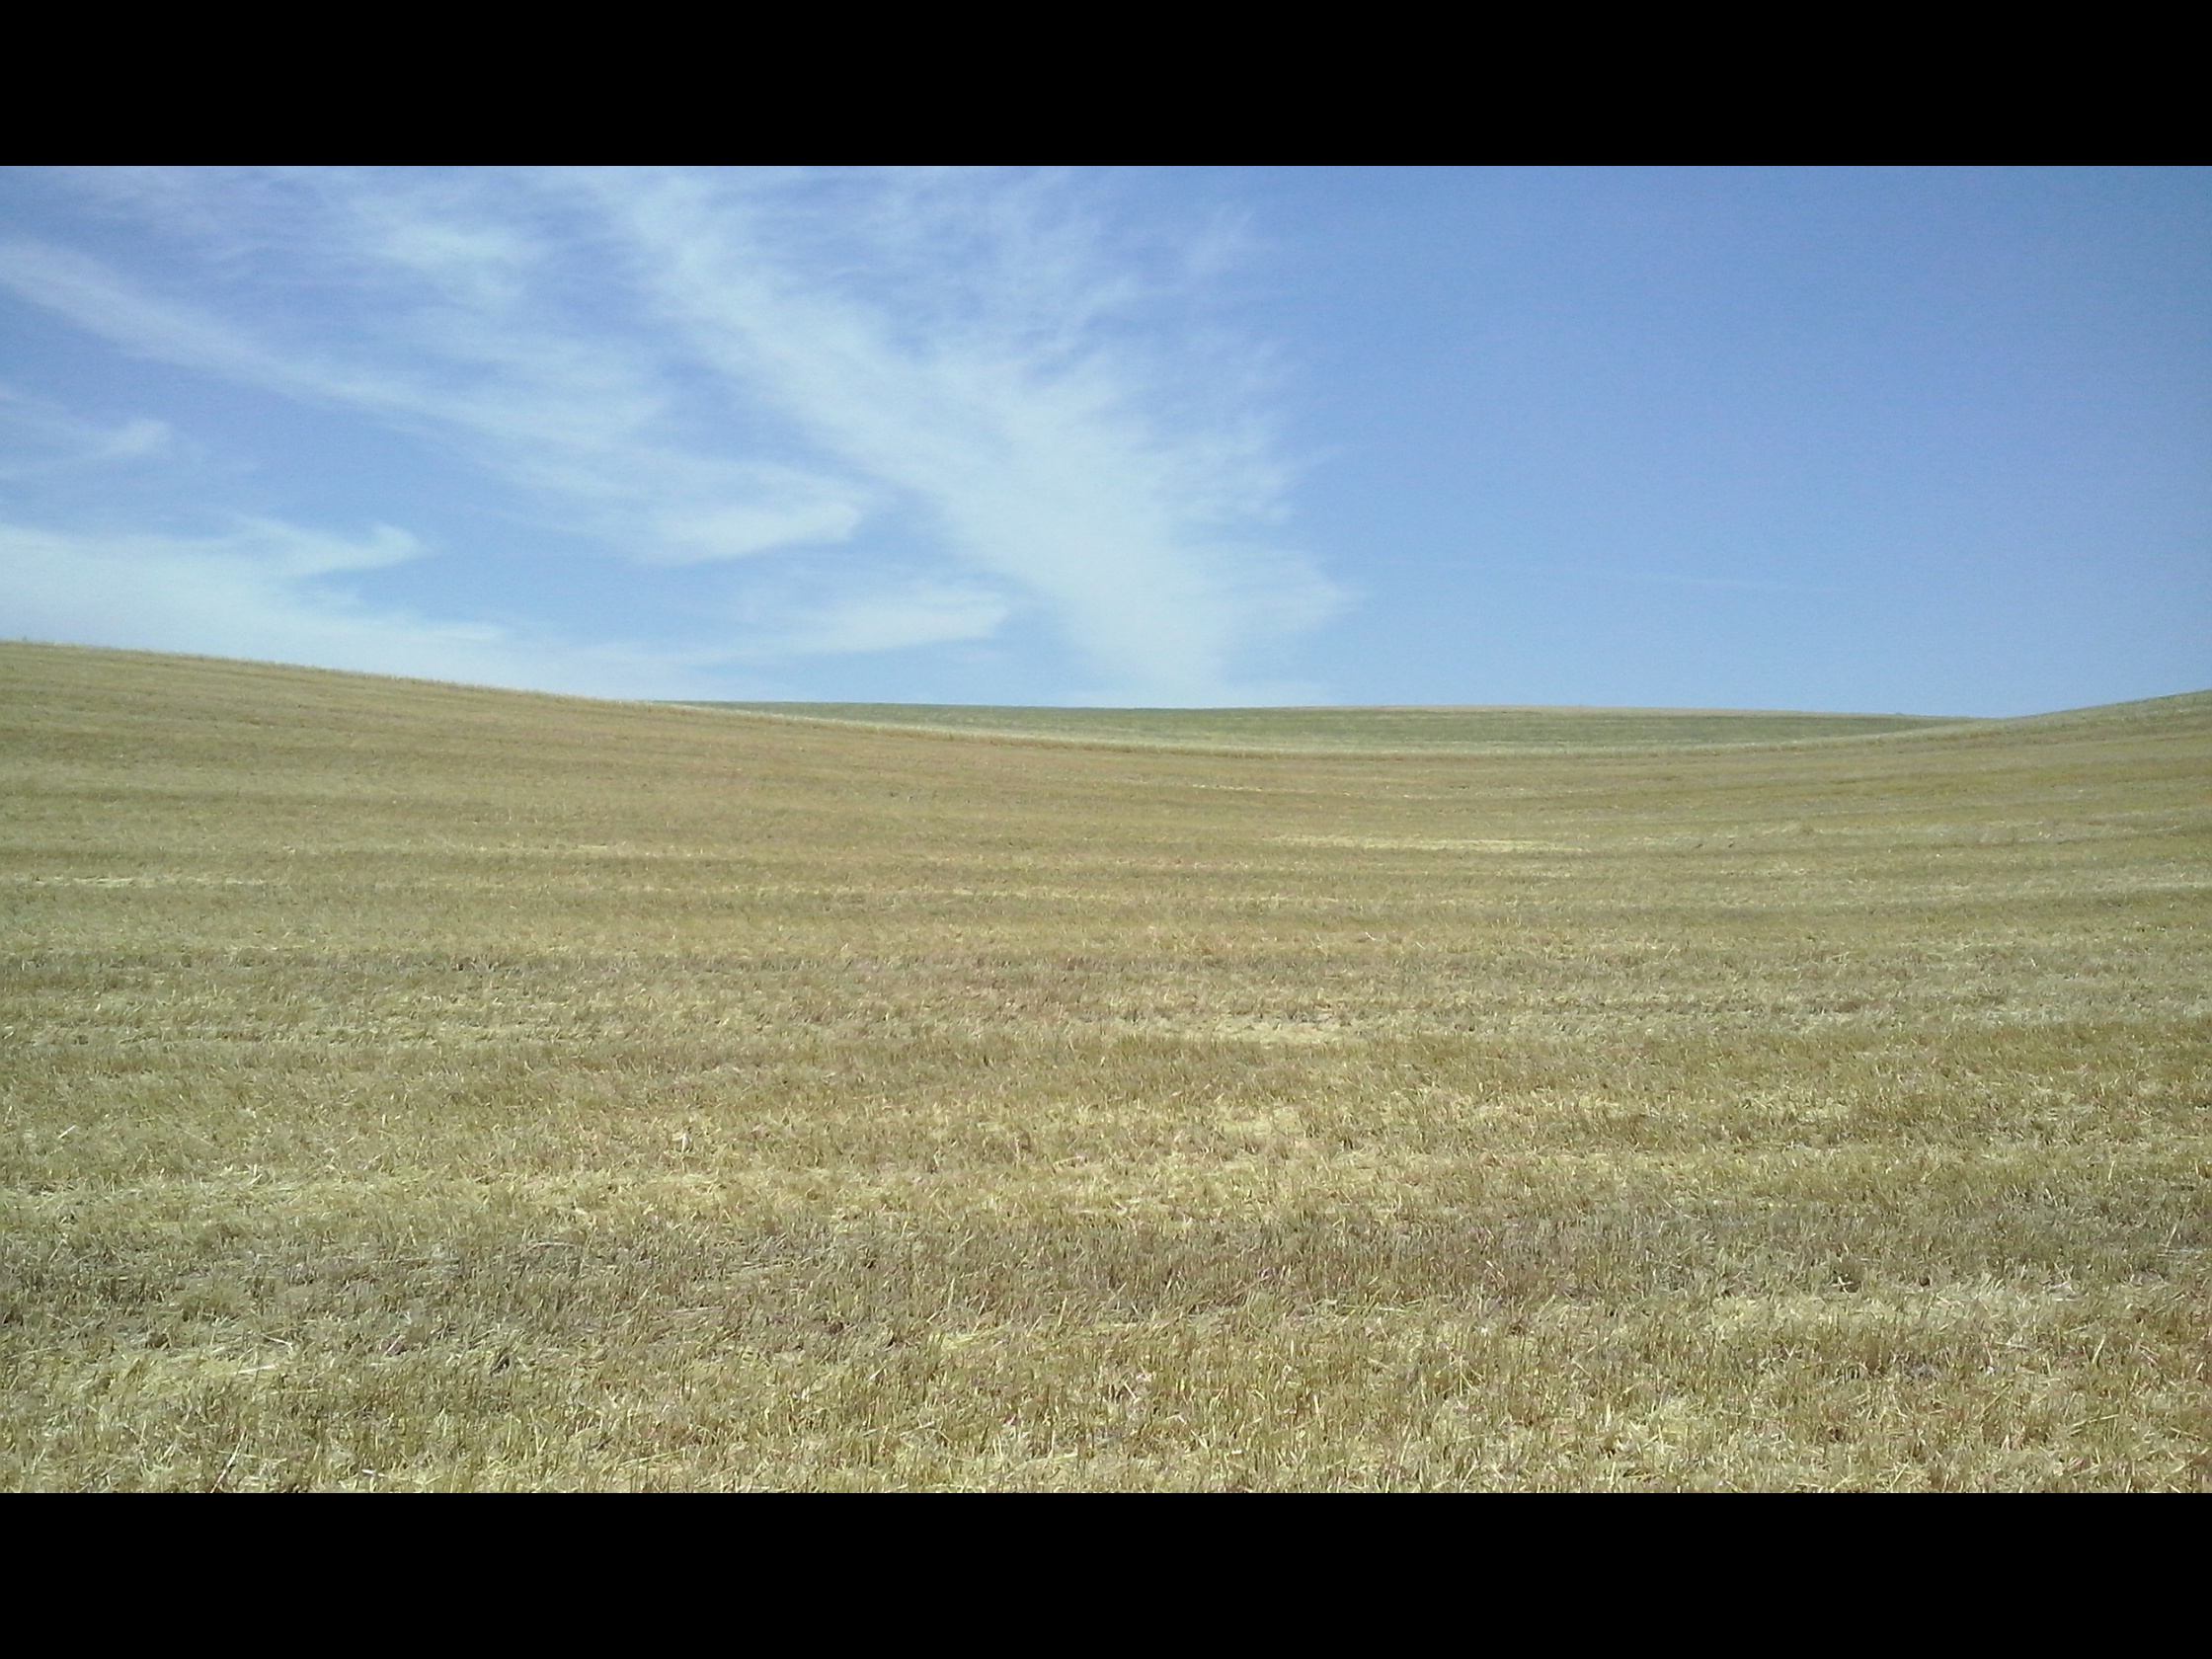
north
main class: Cropland
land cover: Barley
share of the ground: < 10 %
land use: Agriculture (excluding fallow land and kitchen gardens)
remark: Harvested field
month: July
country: ES
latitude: 41.5870
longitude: -5.1055
